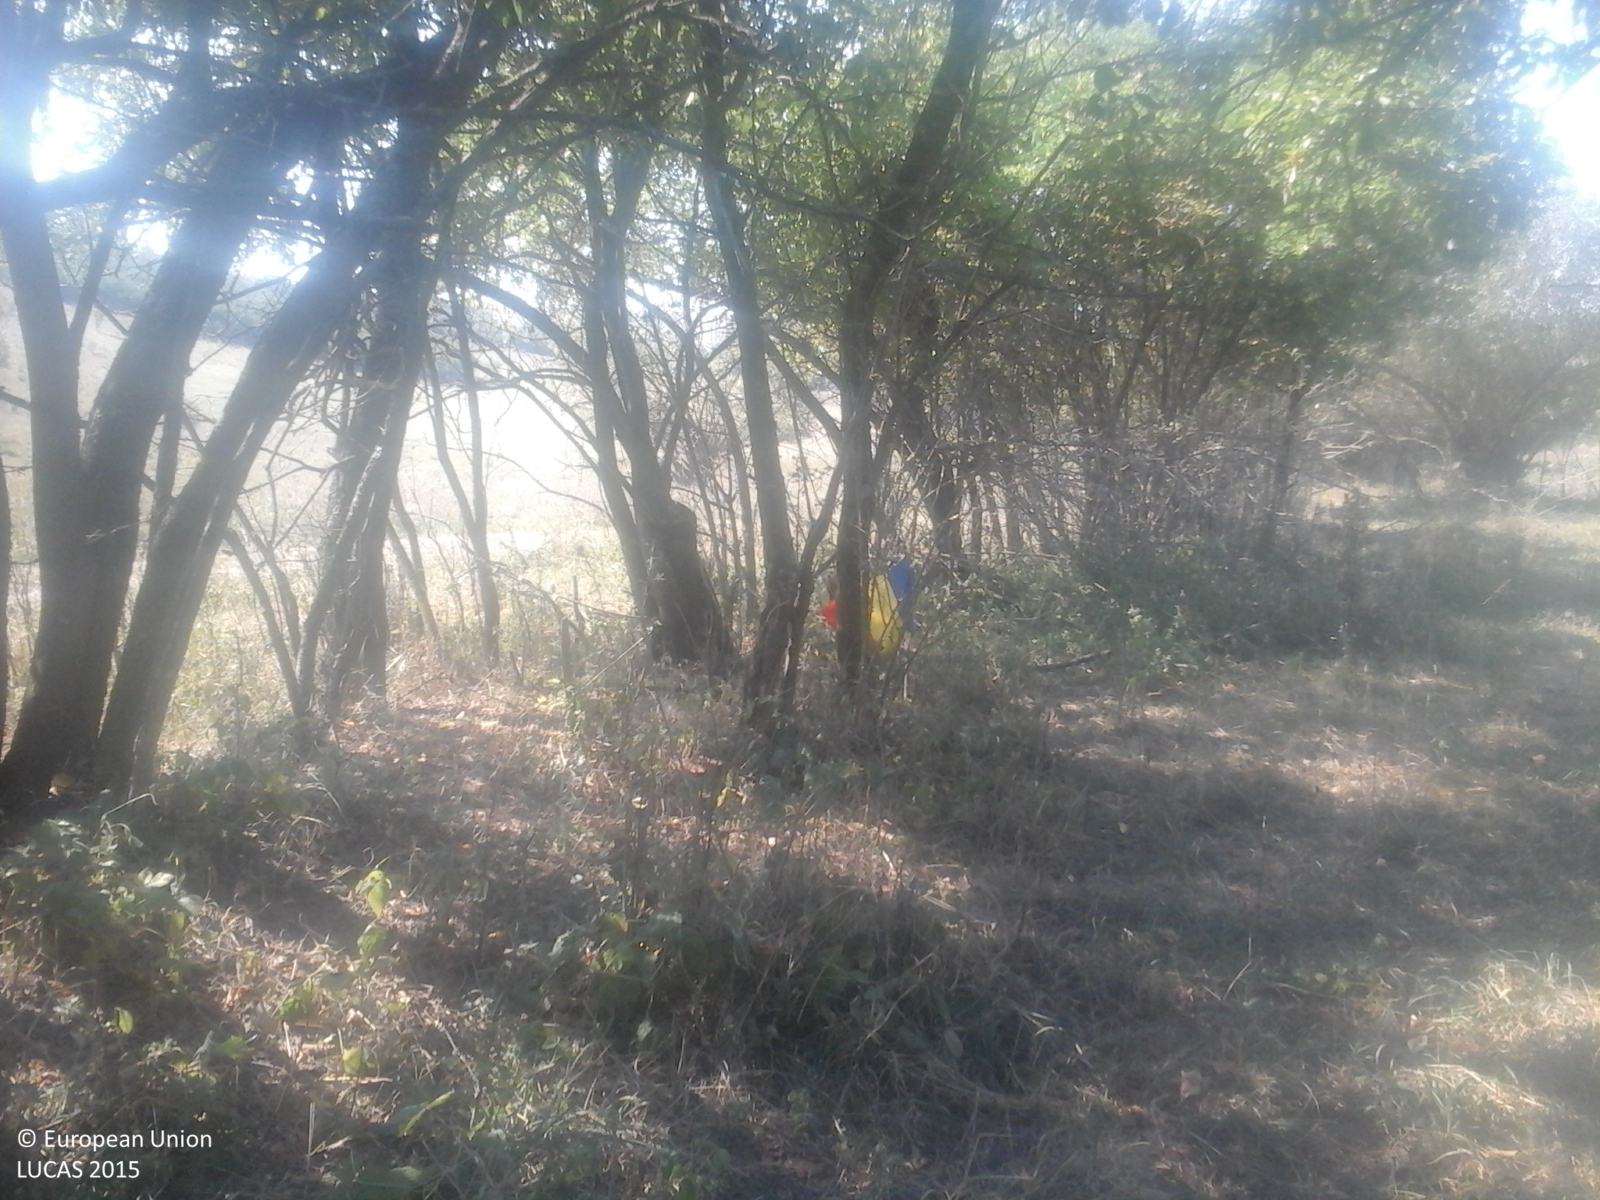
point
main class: Grassland
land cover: Grassland with sparse tree/shrub cover
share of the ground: > 75 %
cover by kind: herbaceous plants 85 %, shrubs 10 %, broadleaved forest trees 5 %
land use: Agriculture (excluding fallow land and kitchen gardens)
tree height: < 5 m
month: September
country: RO
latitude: 46.8063
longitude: 24.4631
